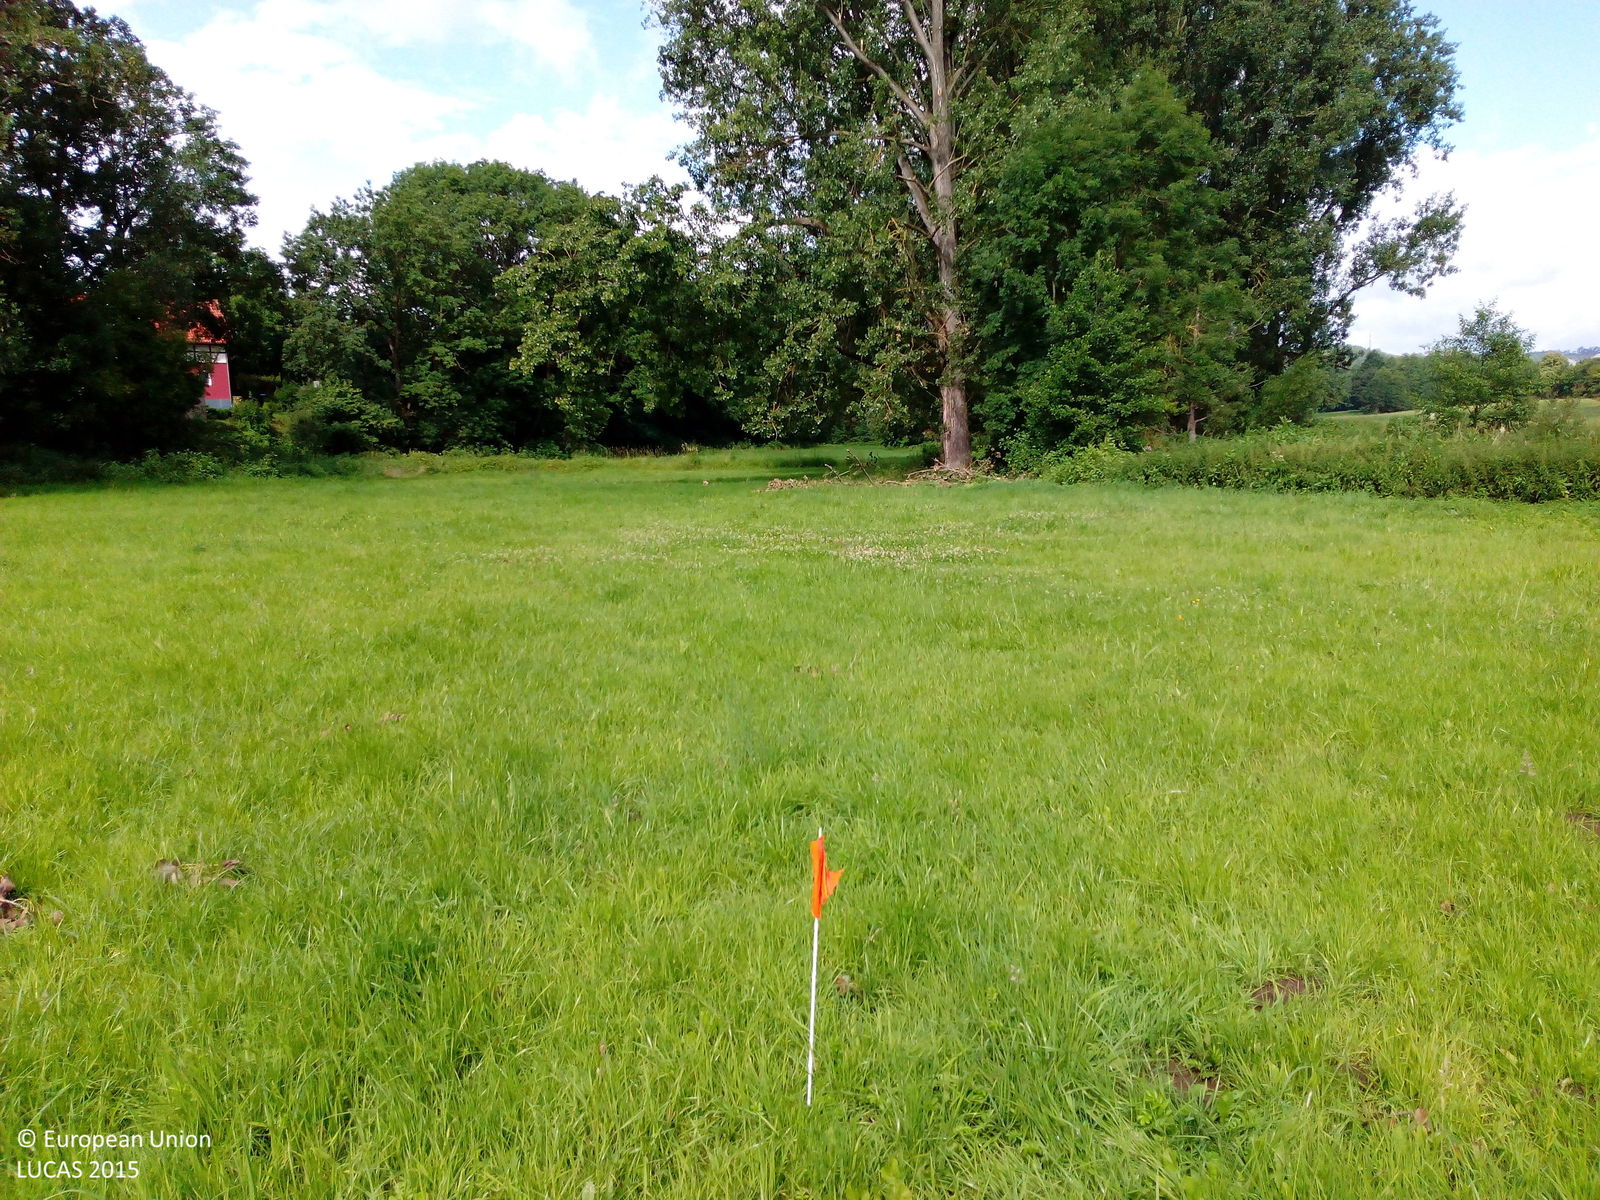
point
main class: Grassland
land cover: Grassland without tree/shrub cover
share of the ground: > 75 %
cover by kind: herbaceous plants 100 %
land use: Agriculture (excluding fallow land and kitchen gardens)
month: July
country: DE
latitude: 51.6404
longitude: 9.8700
